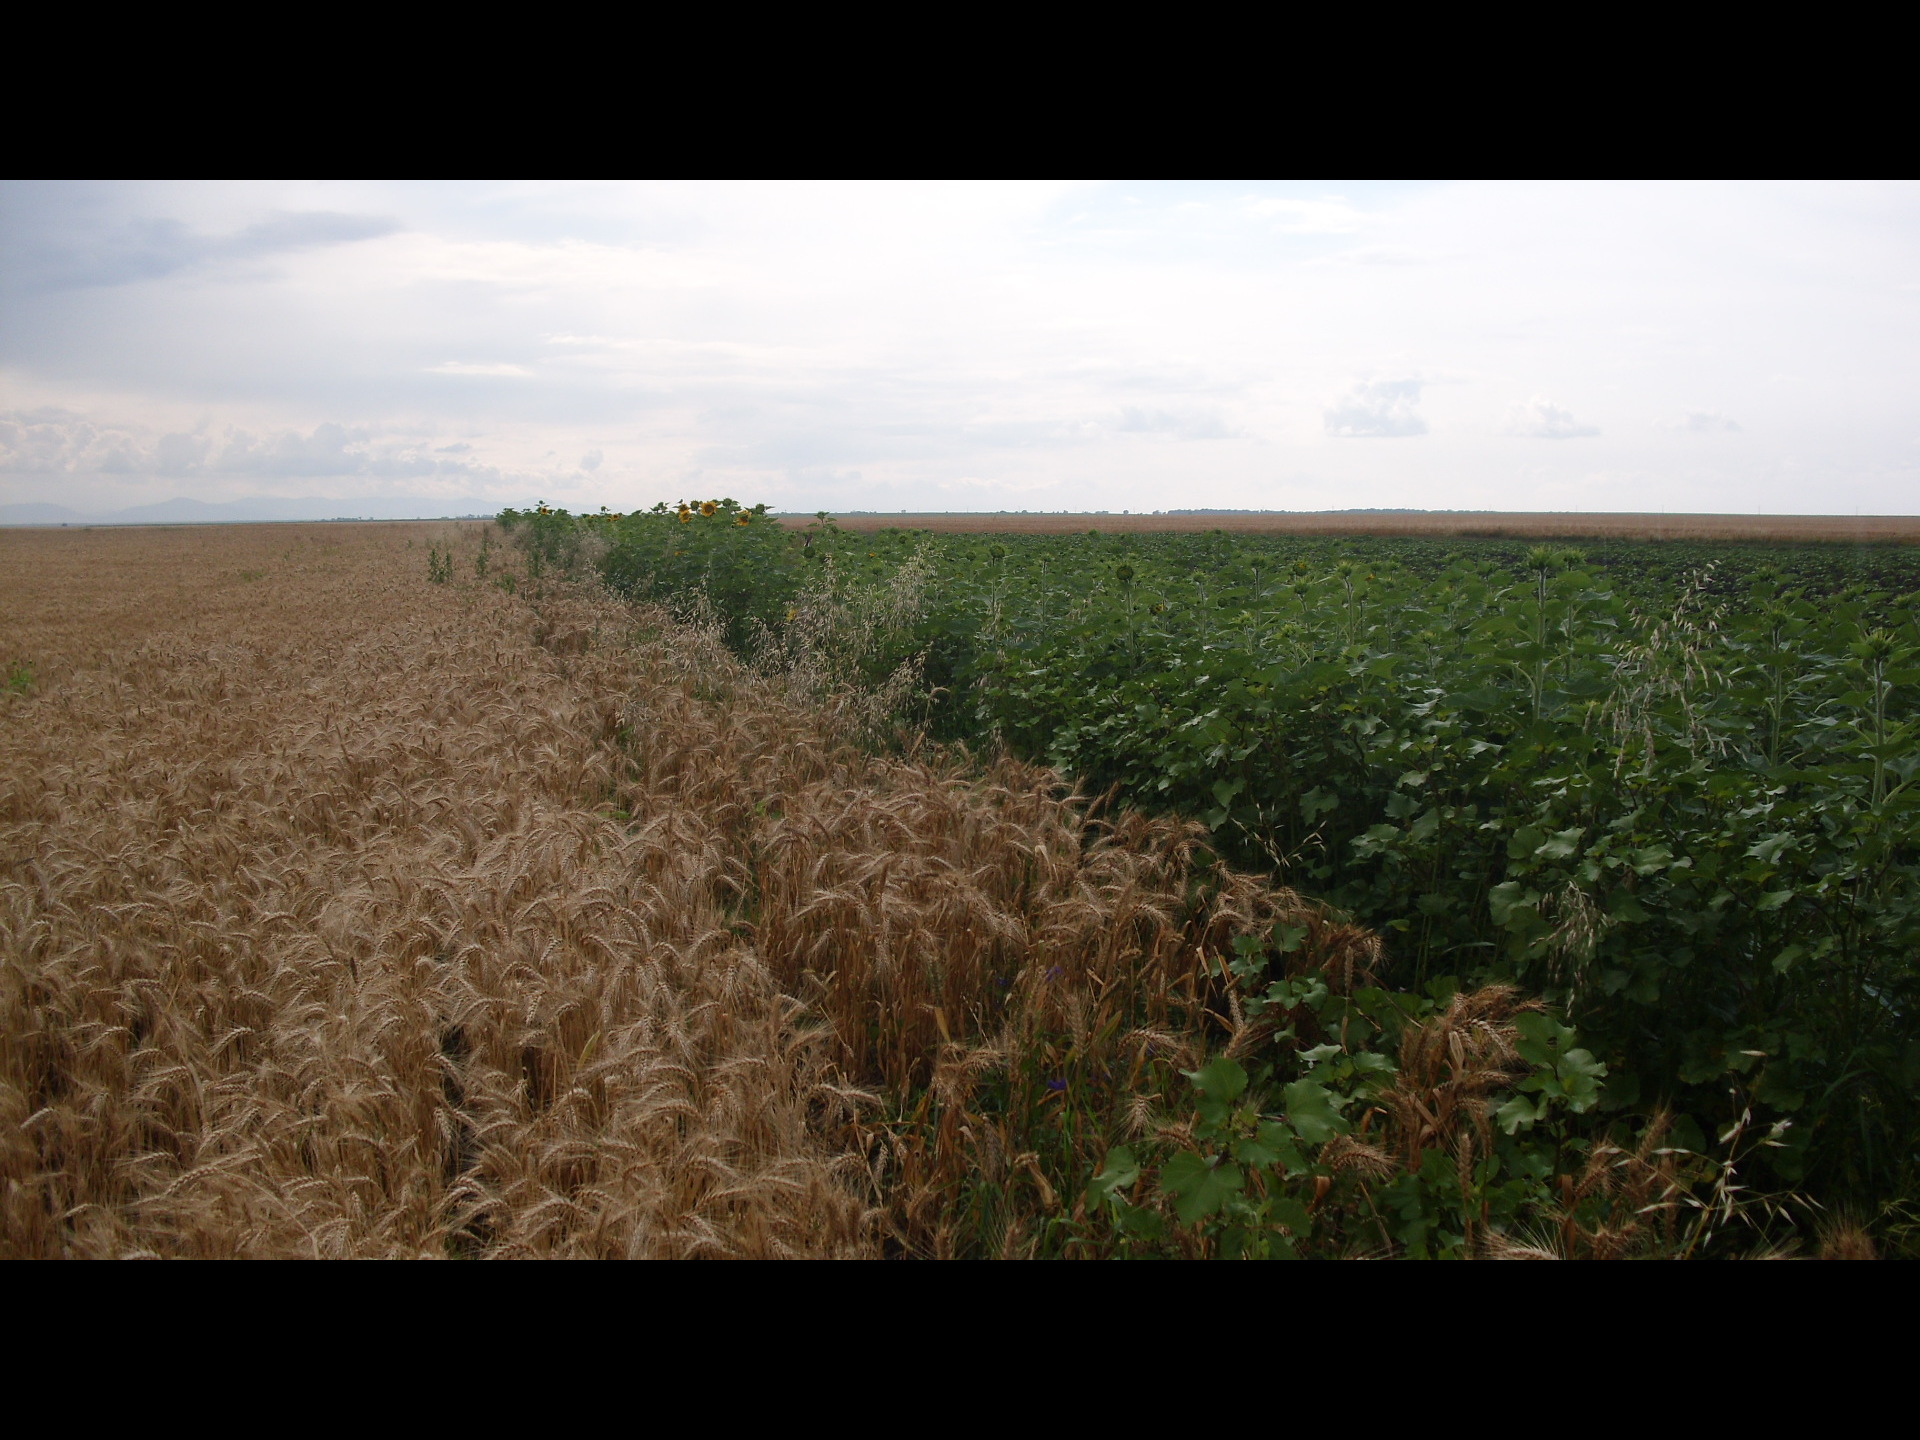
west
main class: Cropland
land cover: Common wheat
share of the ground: > 75 %
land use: Agriculture (excluding fallow land and kitchen gardens)
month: June
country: BG
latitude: 43.5582
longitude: 23.4764
